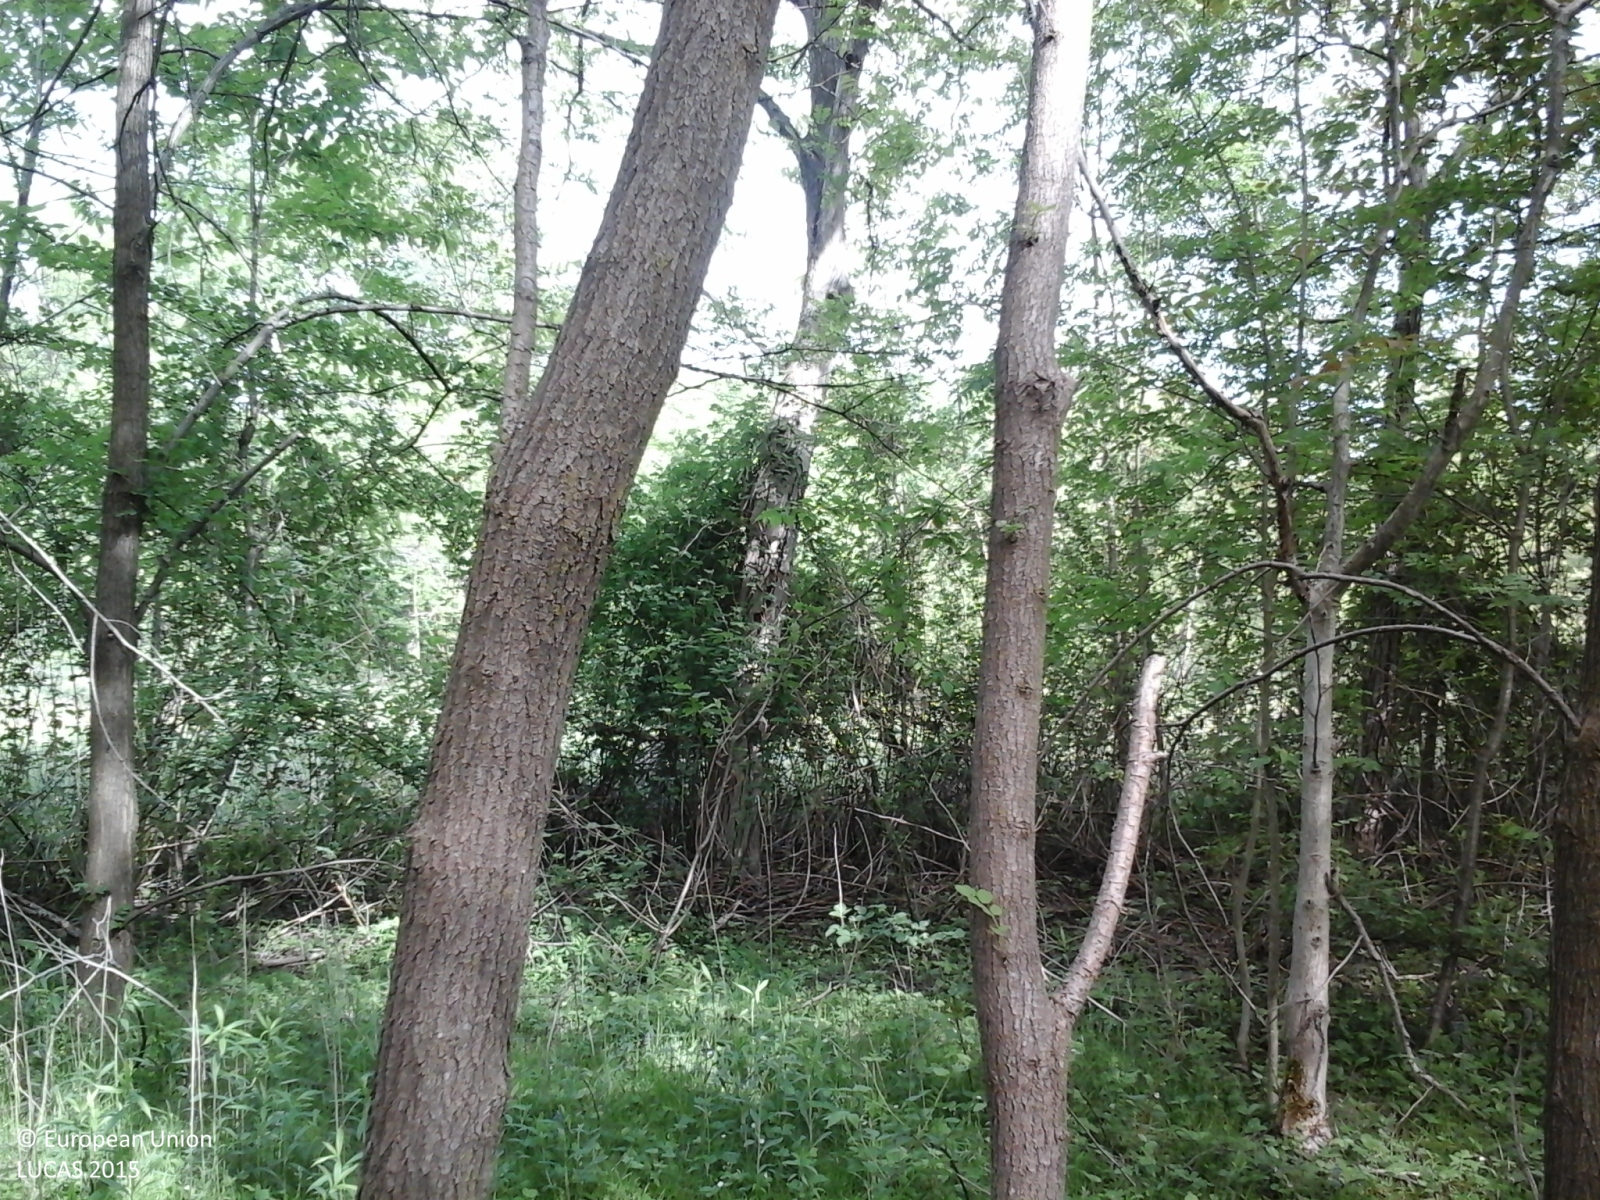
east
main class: Woodland
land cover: Broadleaved woodland
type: thermophilous deciduous forest
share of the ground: > 75 %
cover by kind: broadleaved forest trees 100 %
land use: Forestry
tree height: > 5 m
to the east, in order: Broadleaved woodland; Grassland without tree/shrub cover; Broadleaved woodland; Paved roads, cycling and walking lanes; Broadleaved woodland; Other bare soil; Spontaneously vegetated surfaces
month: May
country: IT
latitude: 45.6556
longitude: 8.4753
